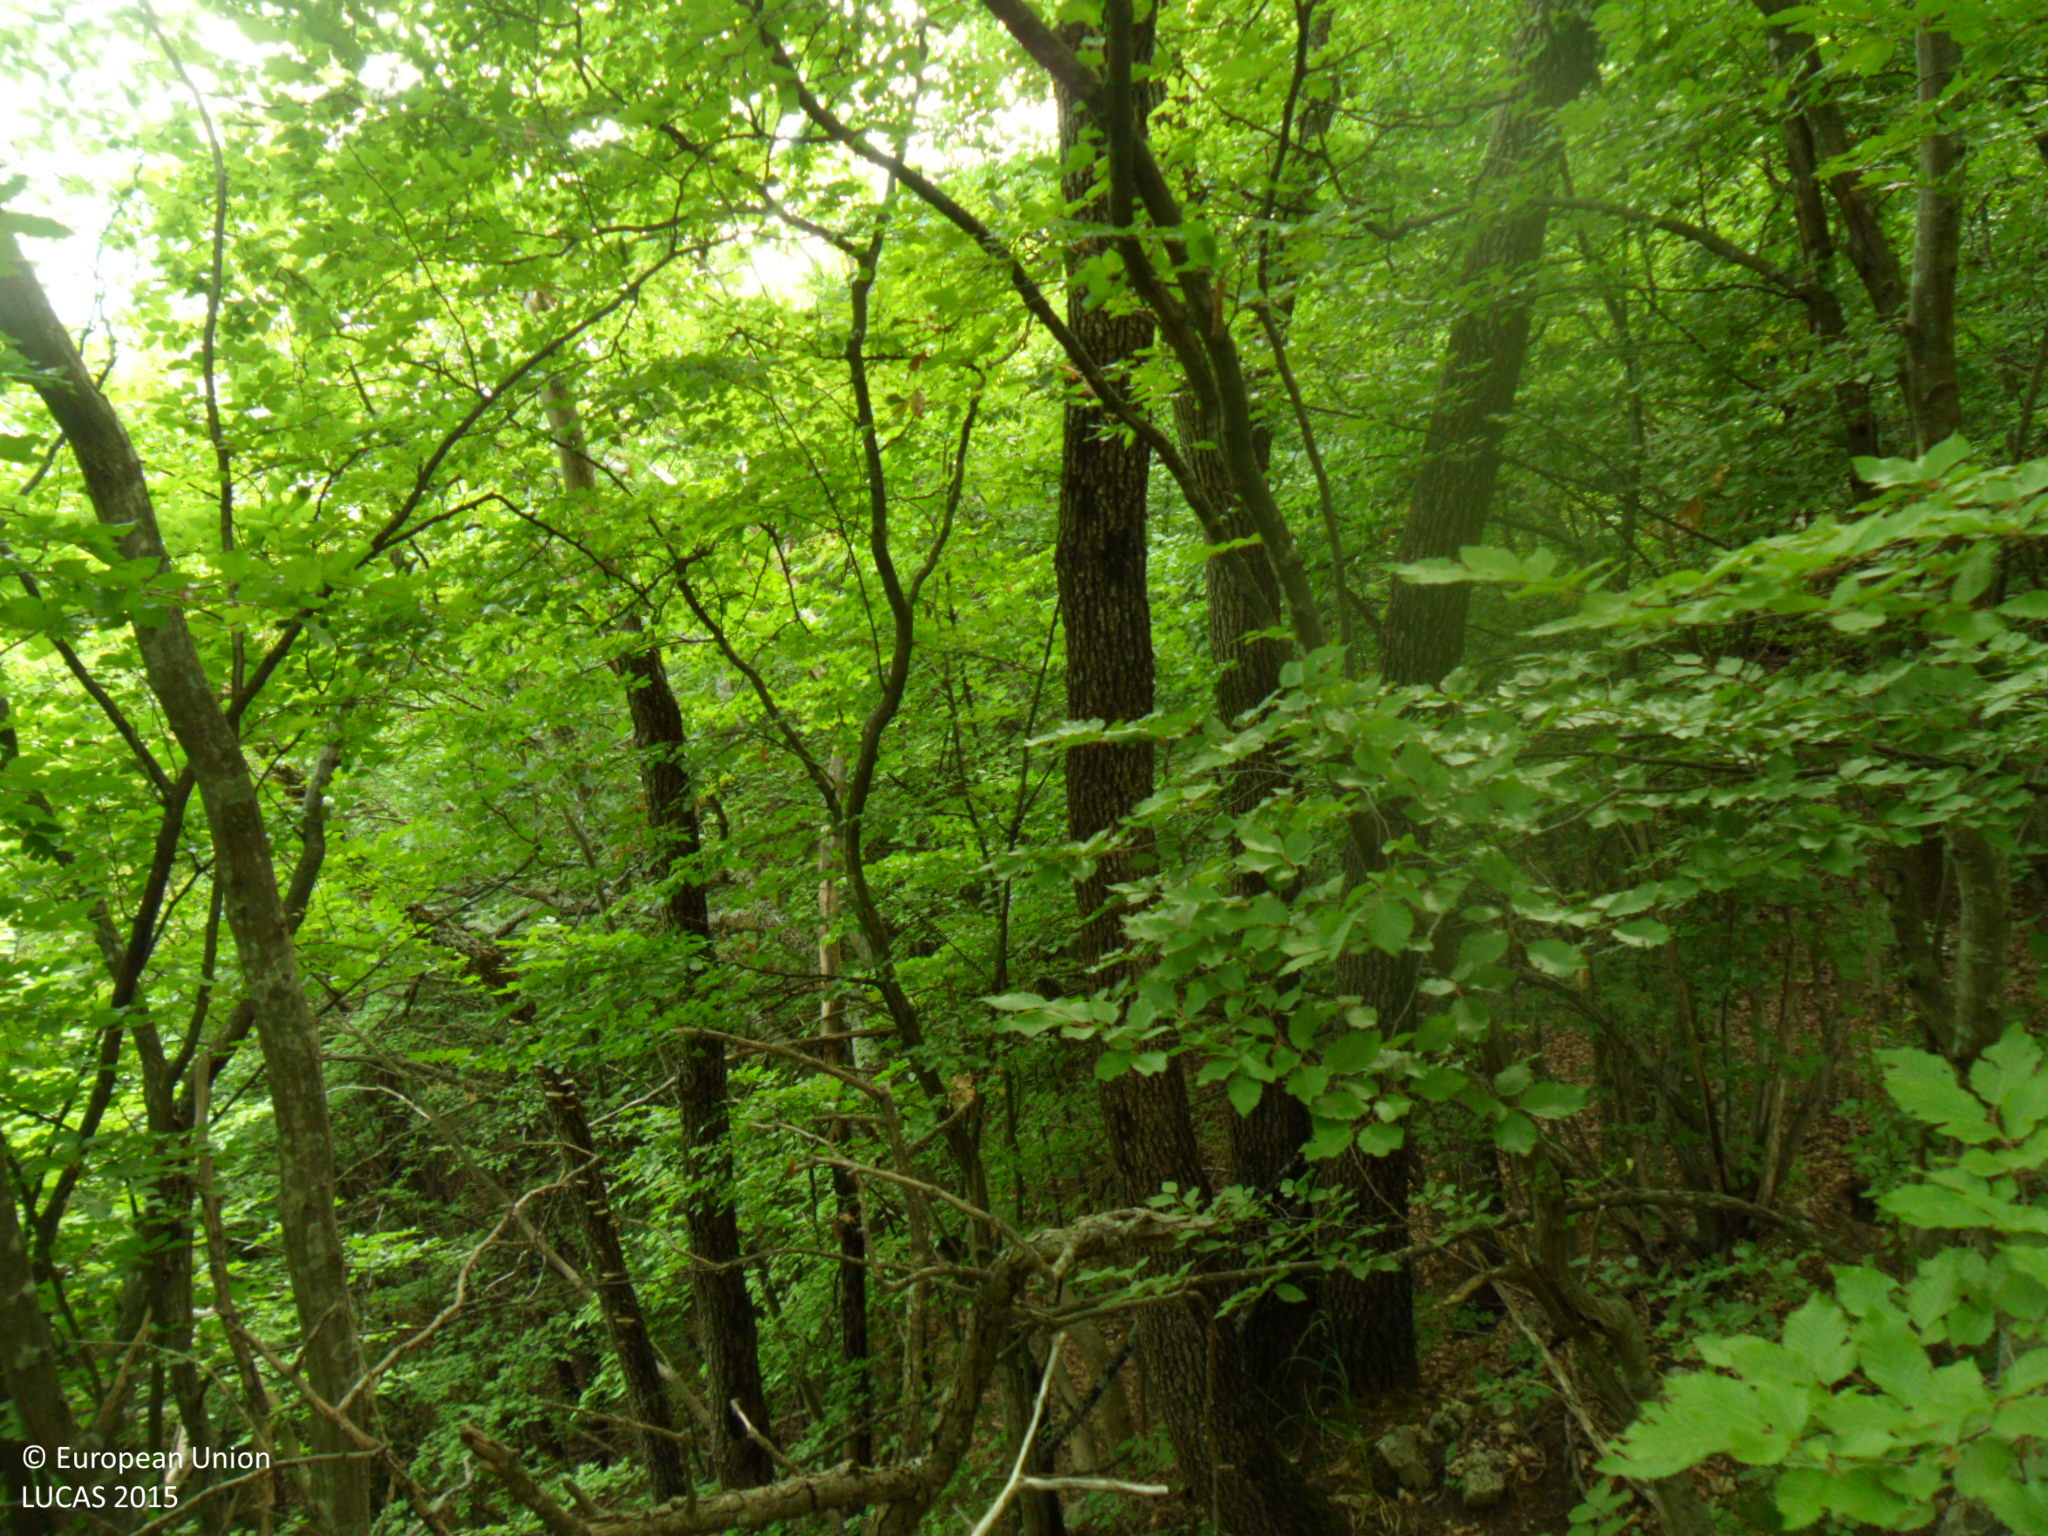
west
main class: Woodland
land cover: Broadleaved woodland
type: beech forest
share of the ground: > 75 %
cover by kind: broadleaved forest trees 100 %
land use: Forestry
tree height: > 5 m
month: June
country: BG
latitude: 43.3195
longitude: 26.7934
